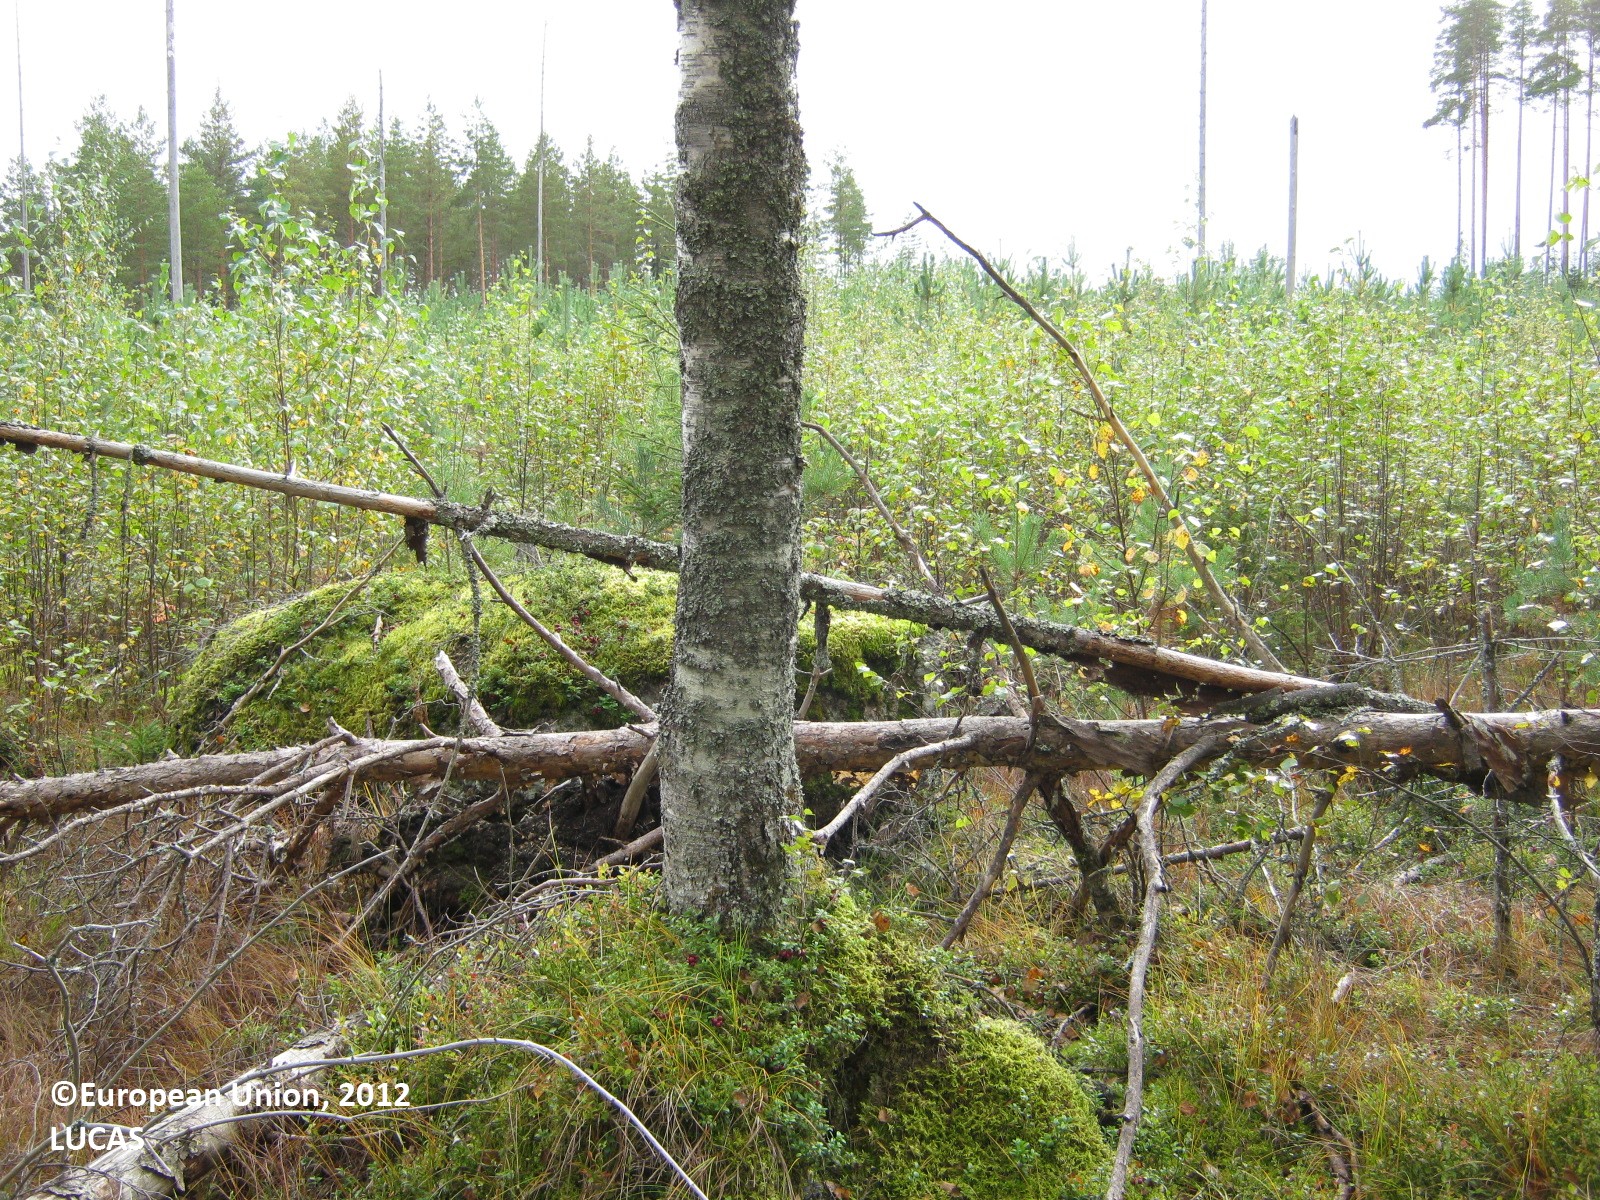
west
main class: Woodland
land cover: Other mixed woodland
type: boreal forest
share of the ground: > 75 %
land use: Forestry
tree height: > 5 m
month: September
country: FI
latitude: 60.8416
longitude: 27.5734
